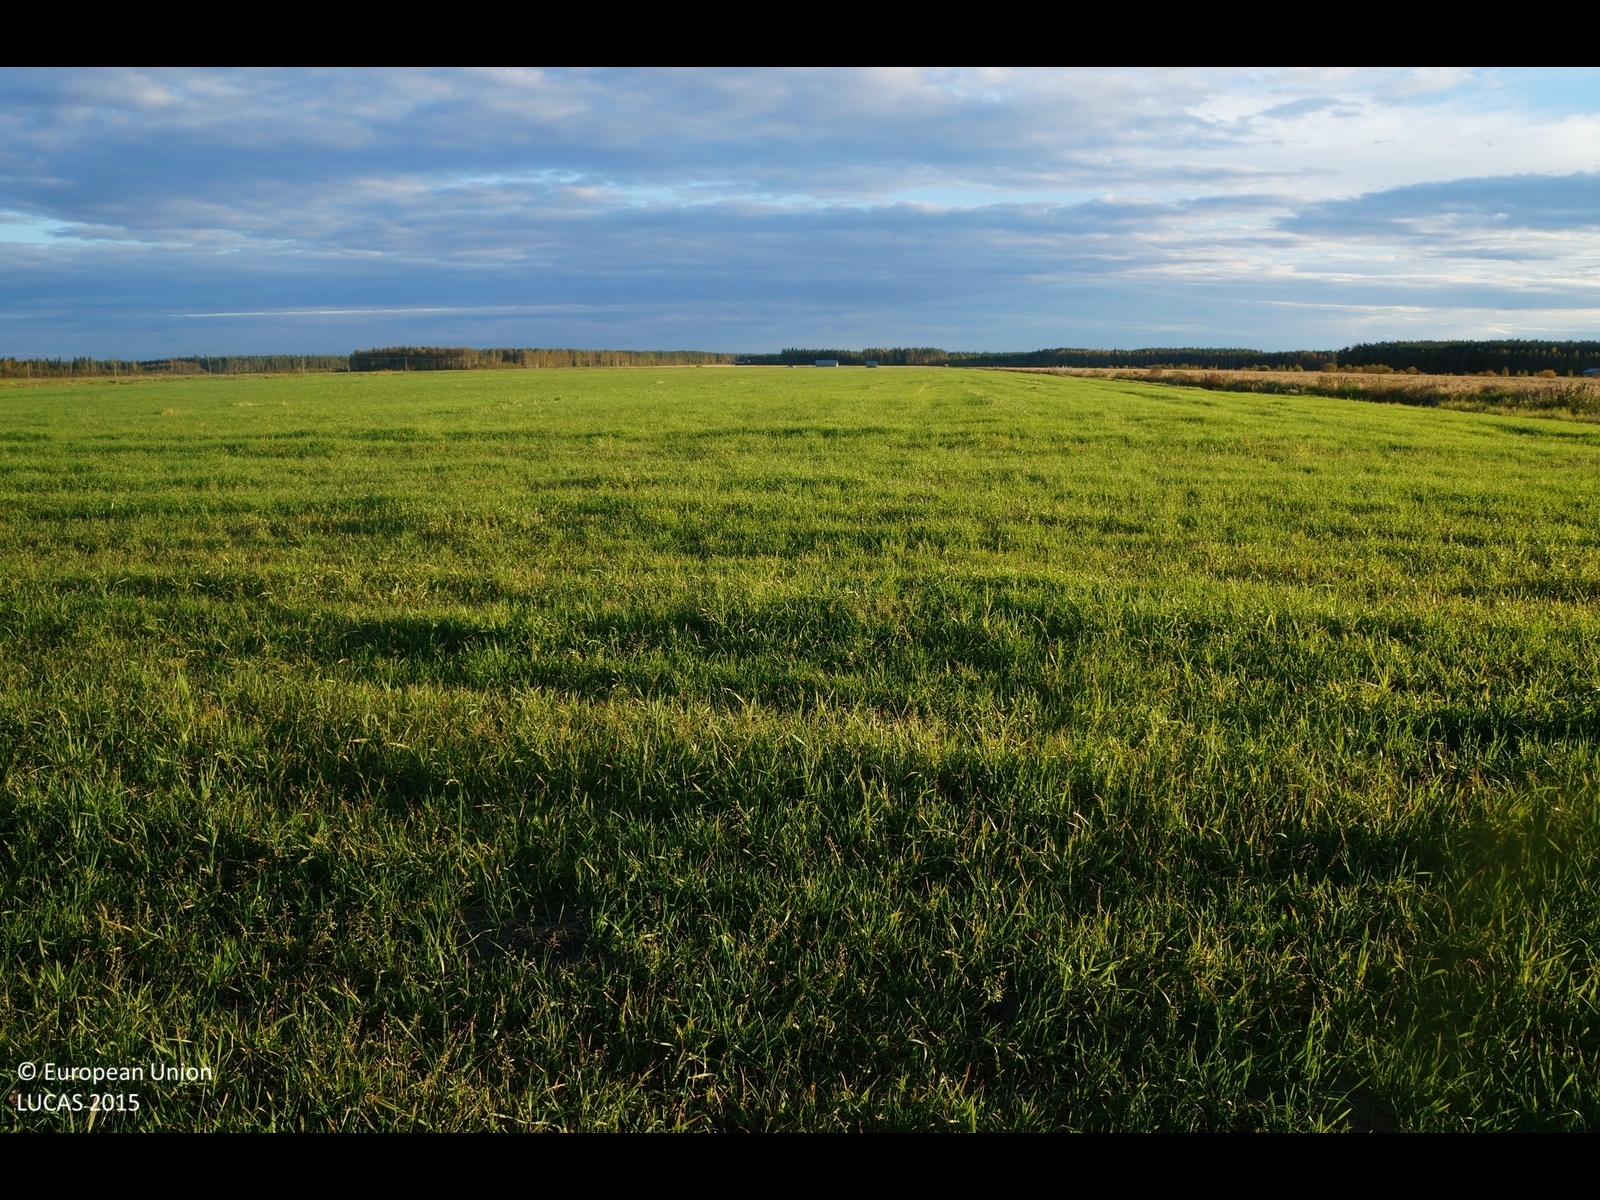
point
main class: Cropland
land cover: Temporary grasslands
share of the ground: > 75 %
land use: Agriculture (excluding fallow land and kitchen gardens)
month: September
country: FI
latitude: 64.1785
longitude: 24.2036
